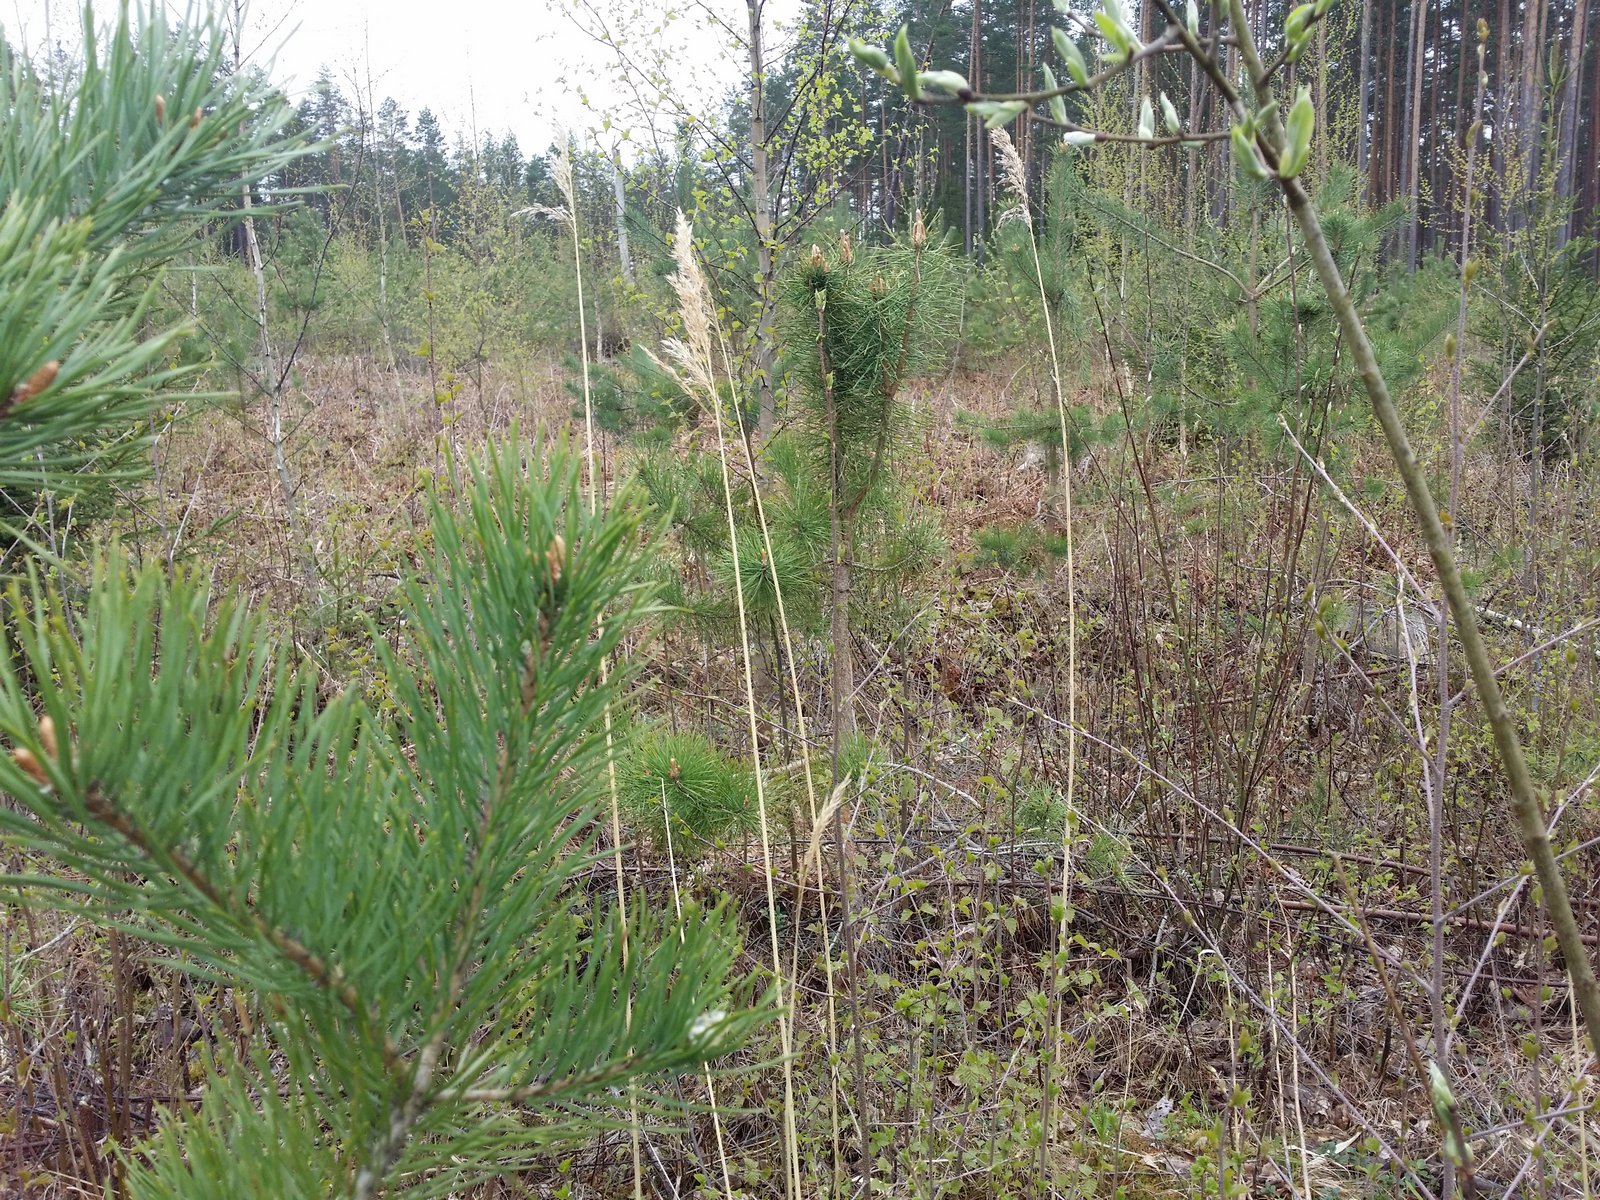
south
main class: Woodland
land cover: Other mixed woodland
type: hemiboreal forest and nemoral coniferous forest and mixed broadleaved-coniferous forest
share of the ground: 50 - 75 %
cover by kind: coniferous forest trees 40 %, broadleaved forest trees 40 %, lichens and mosses 20 %
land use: Forestry
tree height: < 5 m
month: May
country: LV
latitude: 57.4348
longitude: 26.0034
